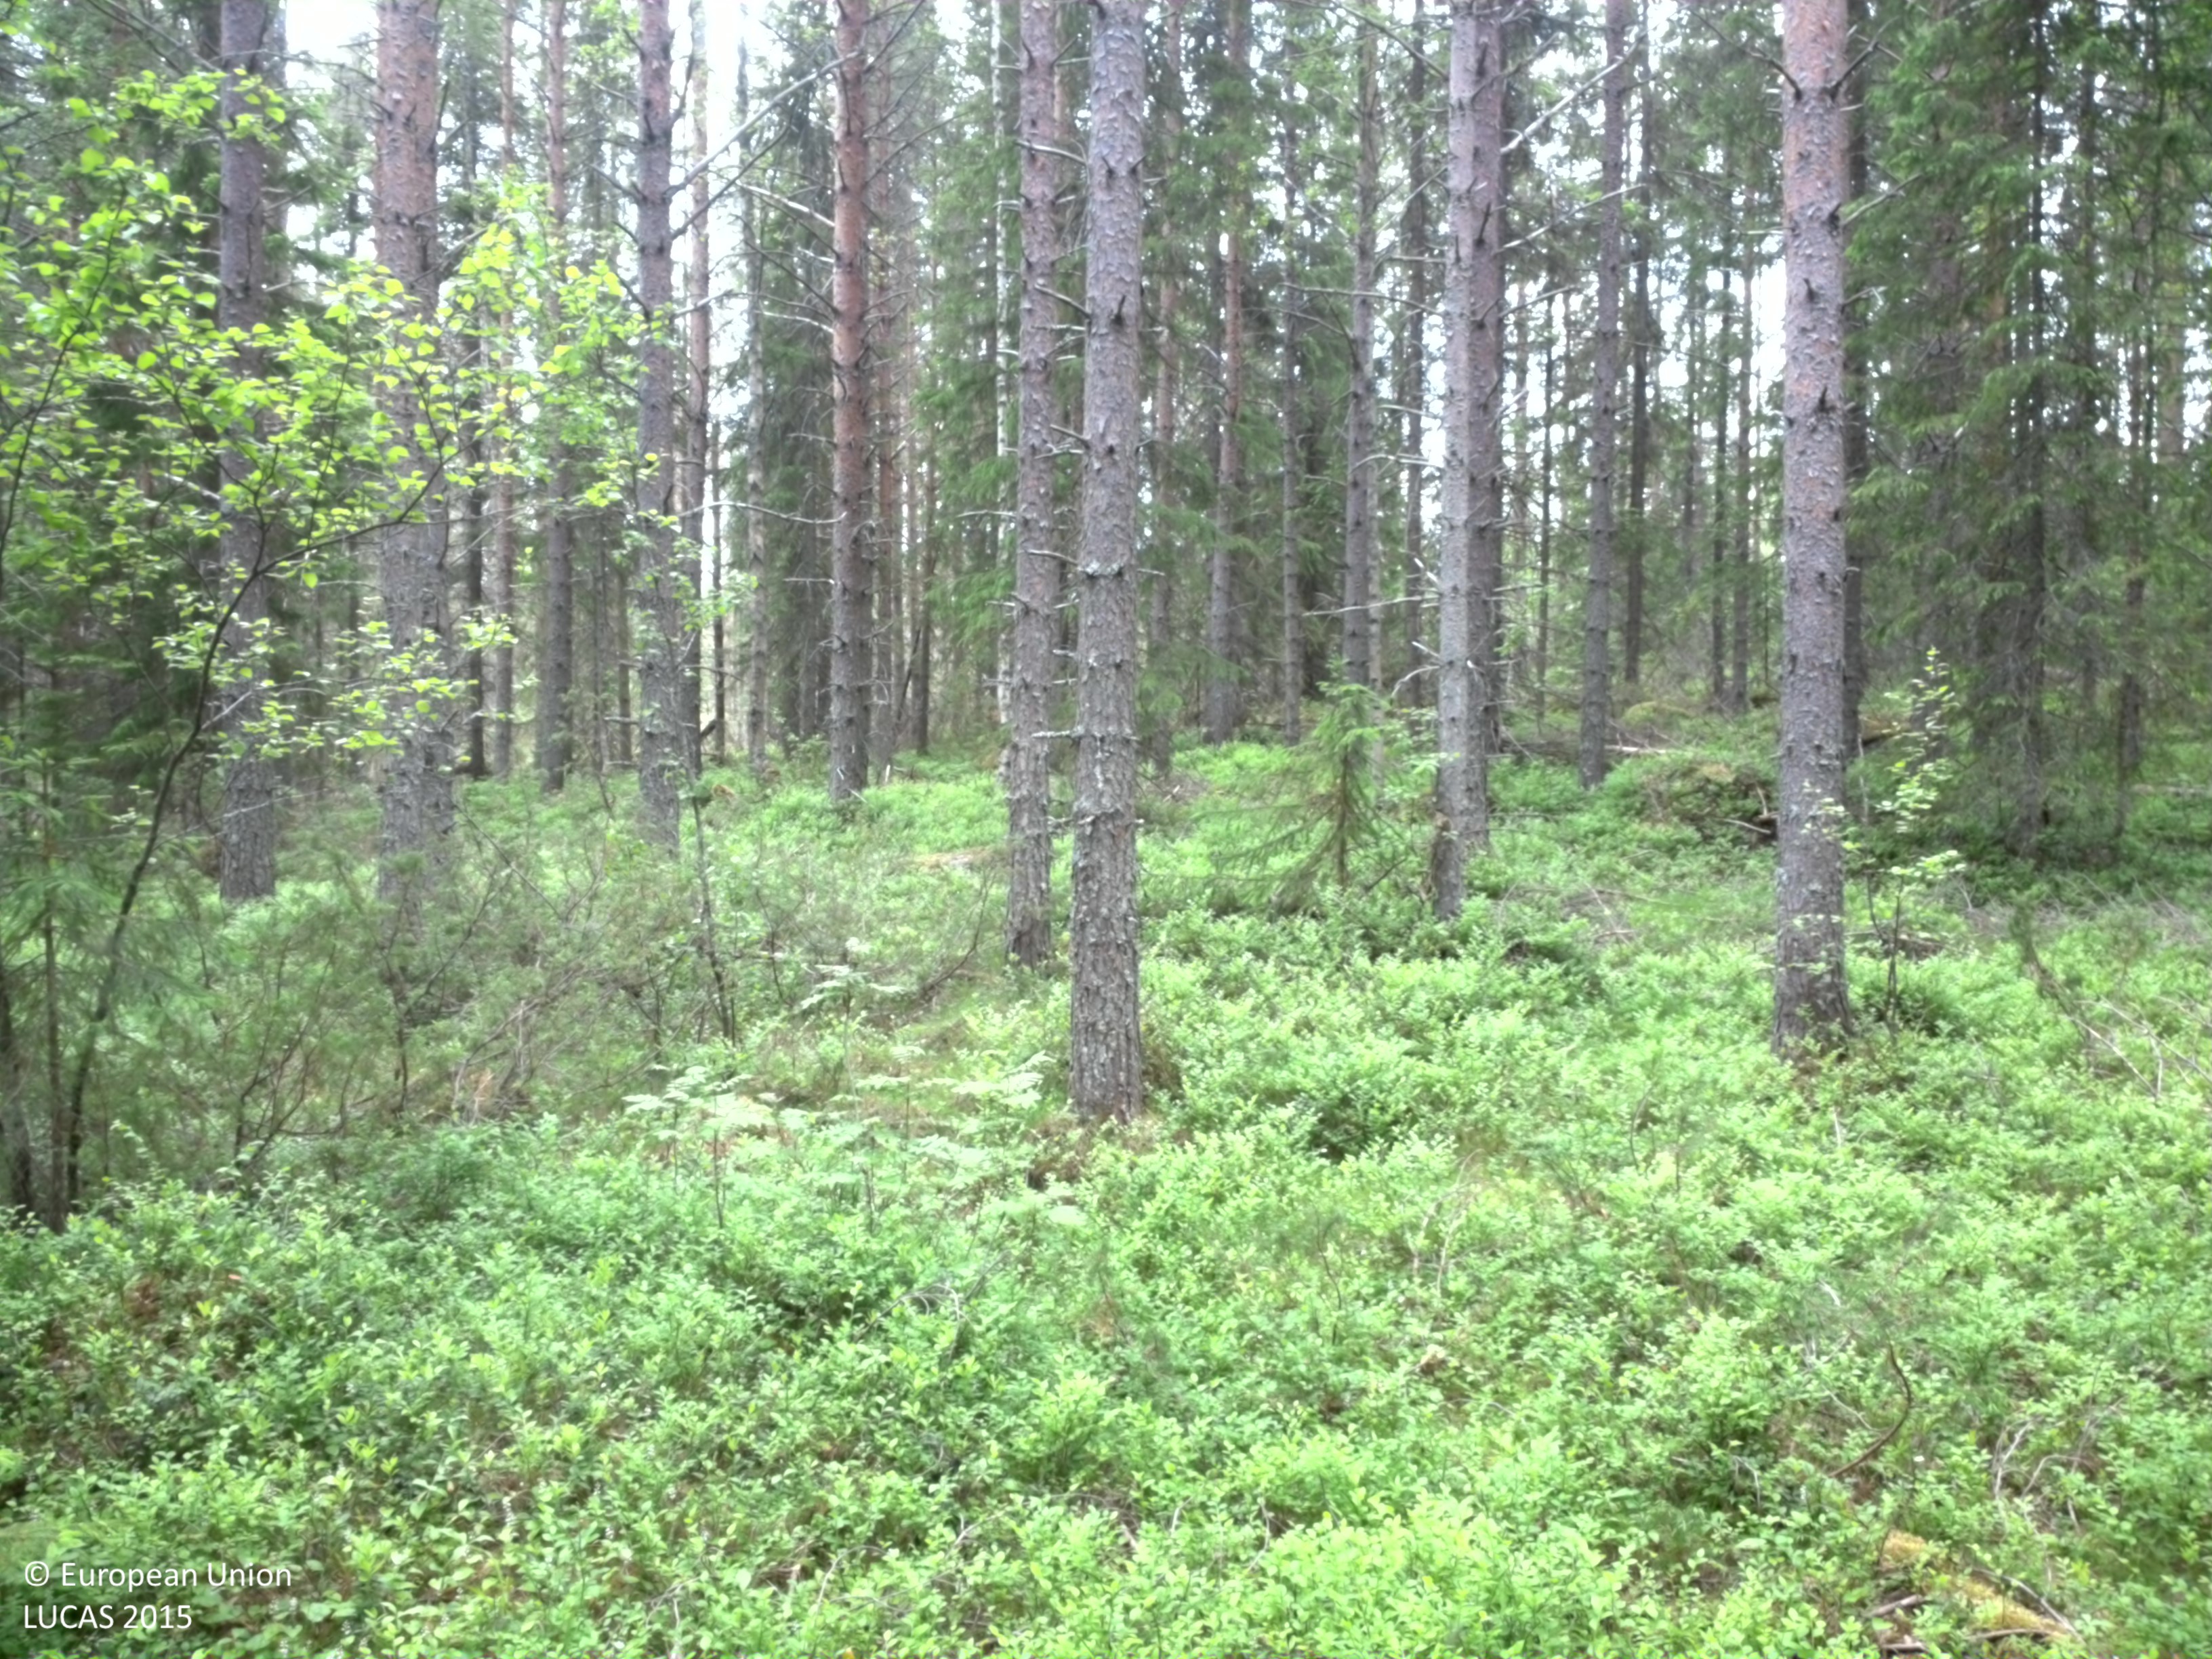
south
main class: Woodland
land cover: Other coniferous woodland
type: boreal forest
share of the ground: 50 - 75 %
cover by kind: coniferous forest trees 65 %, shrubs 25 %, broadleaved forest trees 10 %
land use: Forestry
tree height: > 5 m
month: July
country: SE
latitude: 64.4512
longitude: 20.7651
